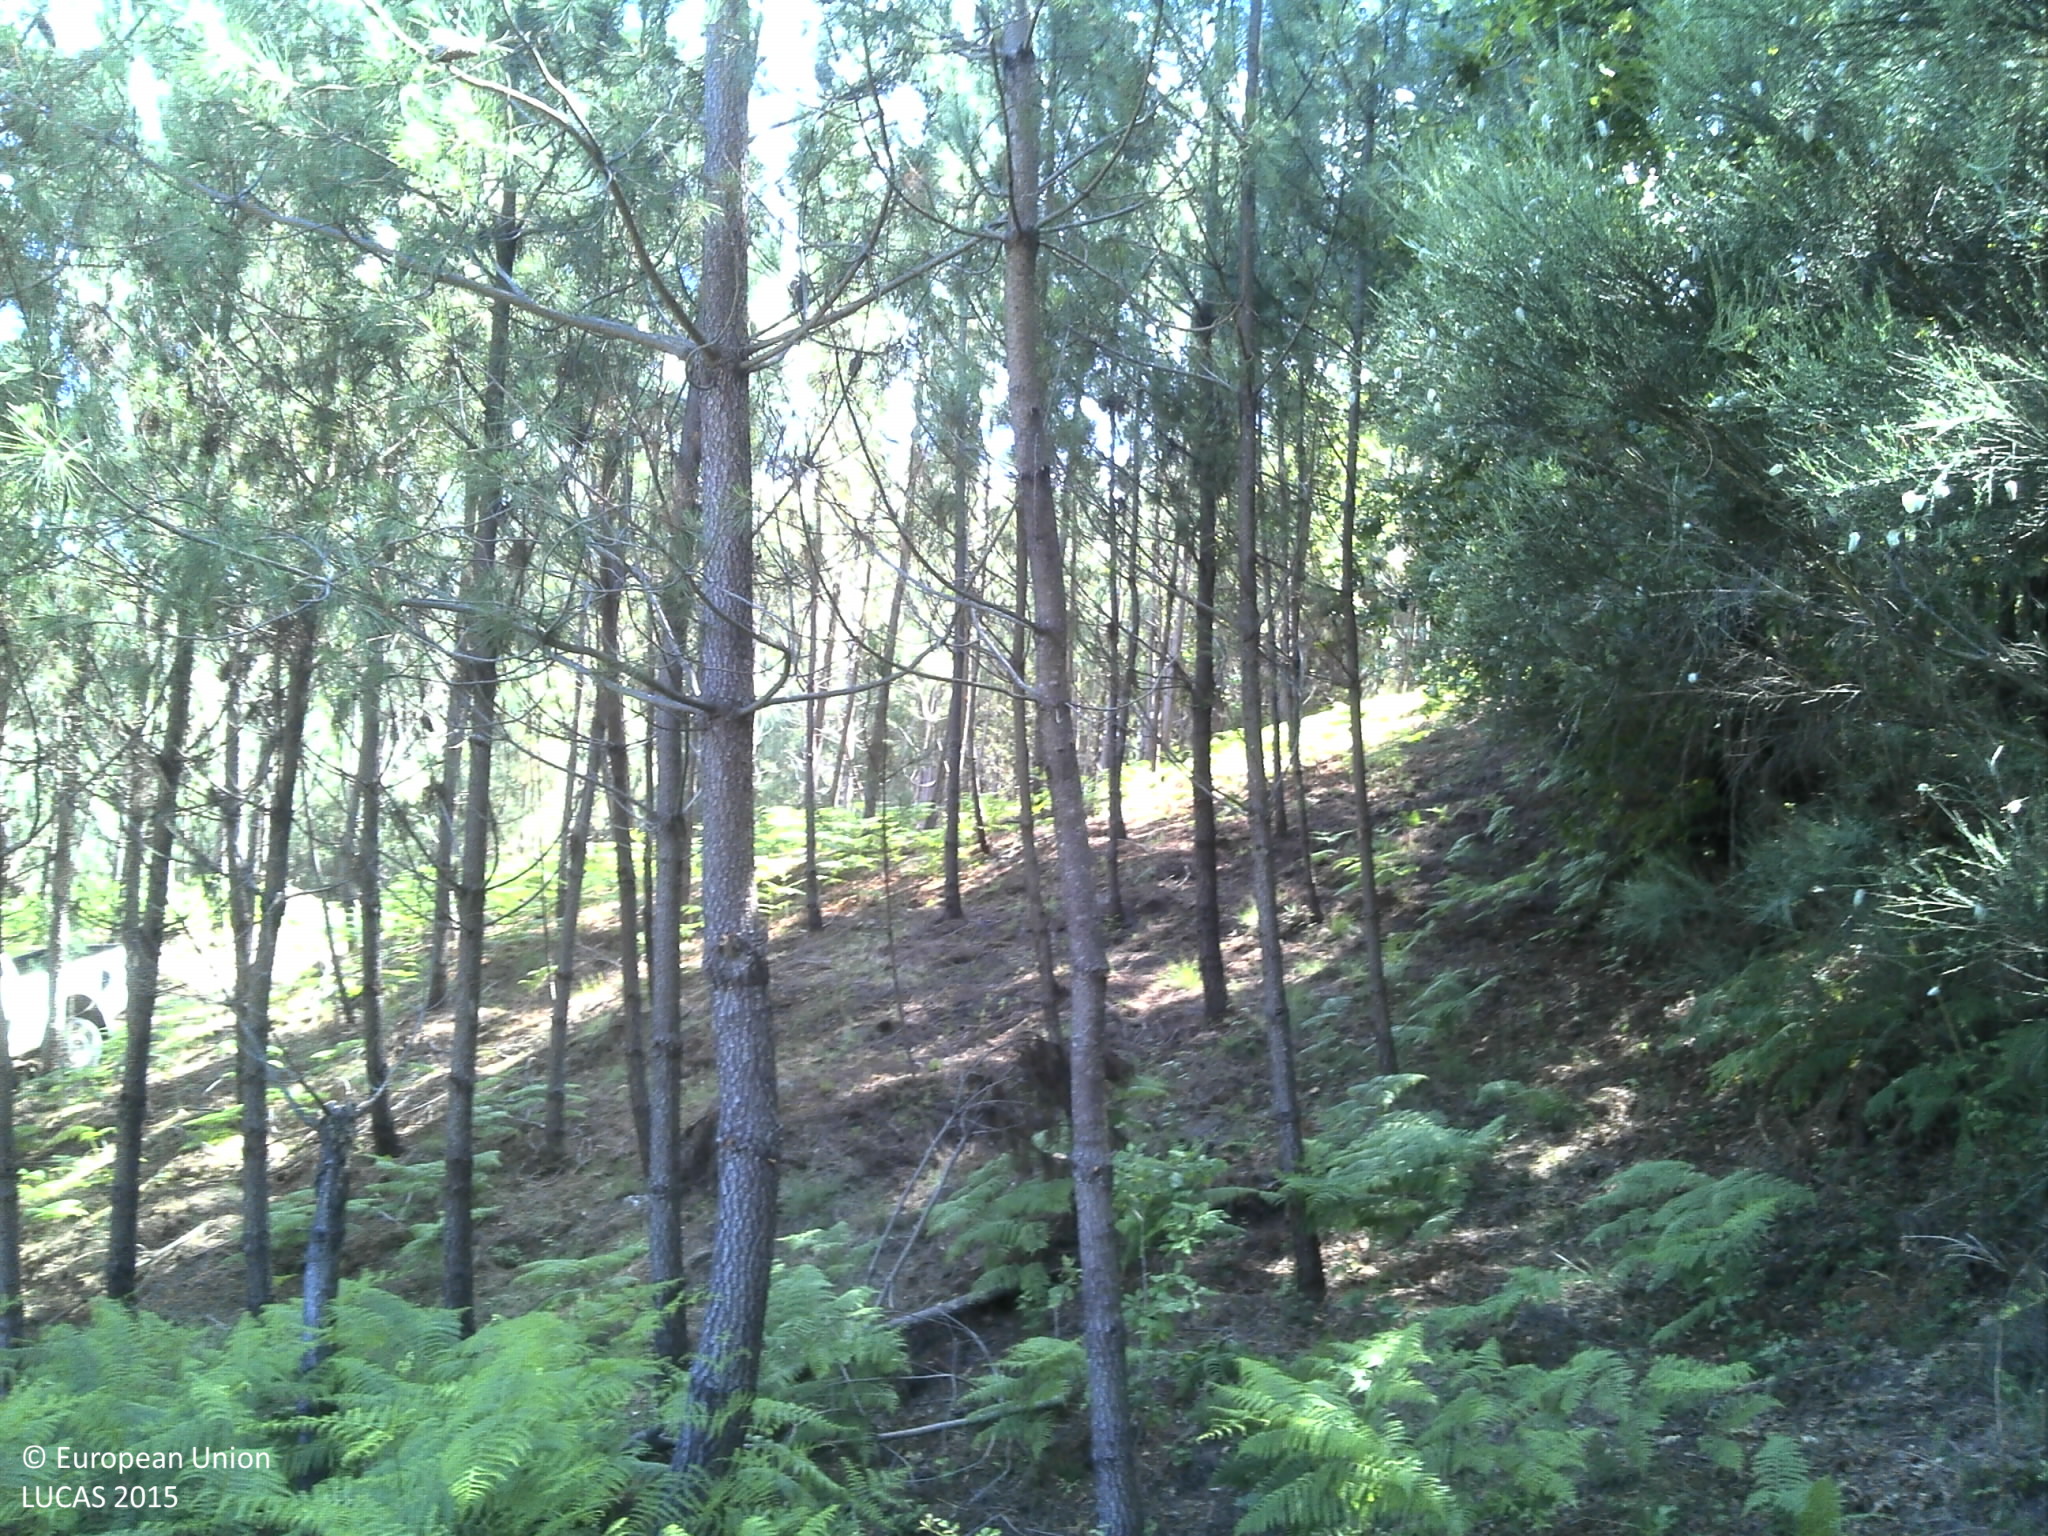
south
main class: Woodland
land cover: Pine dominated coniferous woodland
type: coniferous forest of the mediterranean region
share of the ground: 25 - 50 %
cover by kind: coniferous forest trees 50 %, shrubs 30 %, consolidated bare surface 10 %, herbaceous plants 5 %, unconsolidated bare surface 5 %
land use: Forestry
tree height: > 5 m
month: June
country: PT
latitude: 40.8622
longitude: -7.9849
